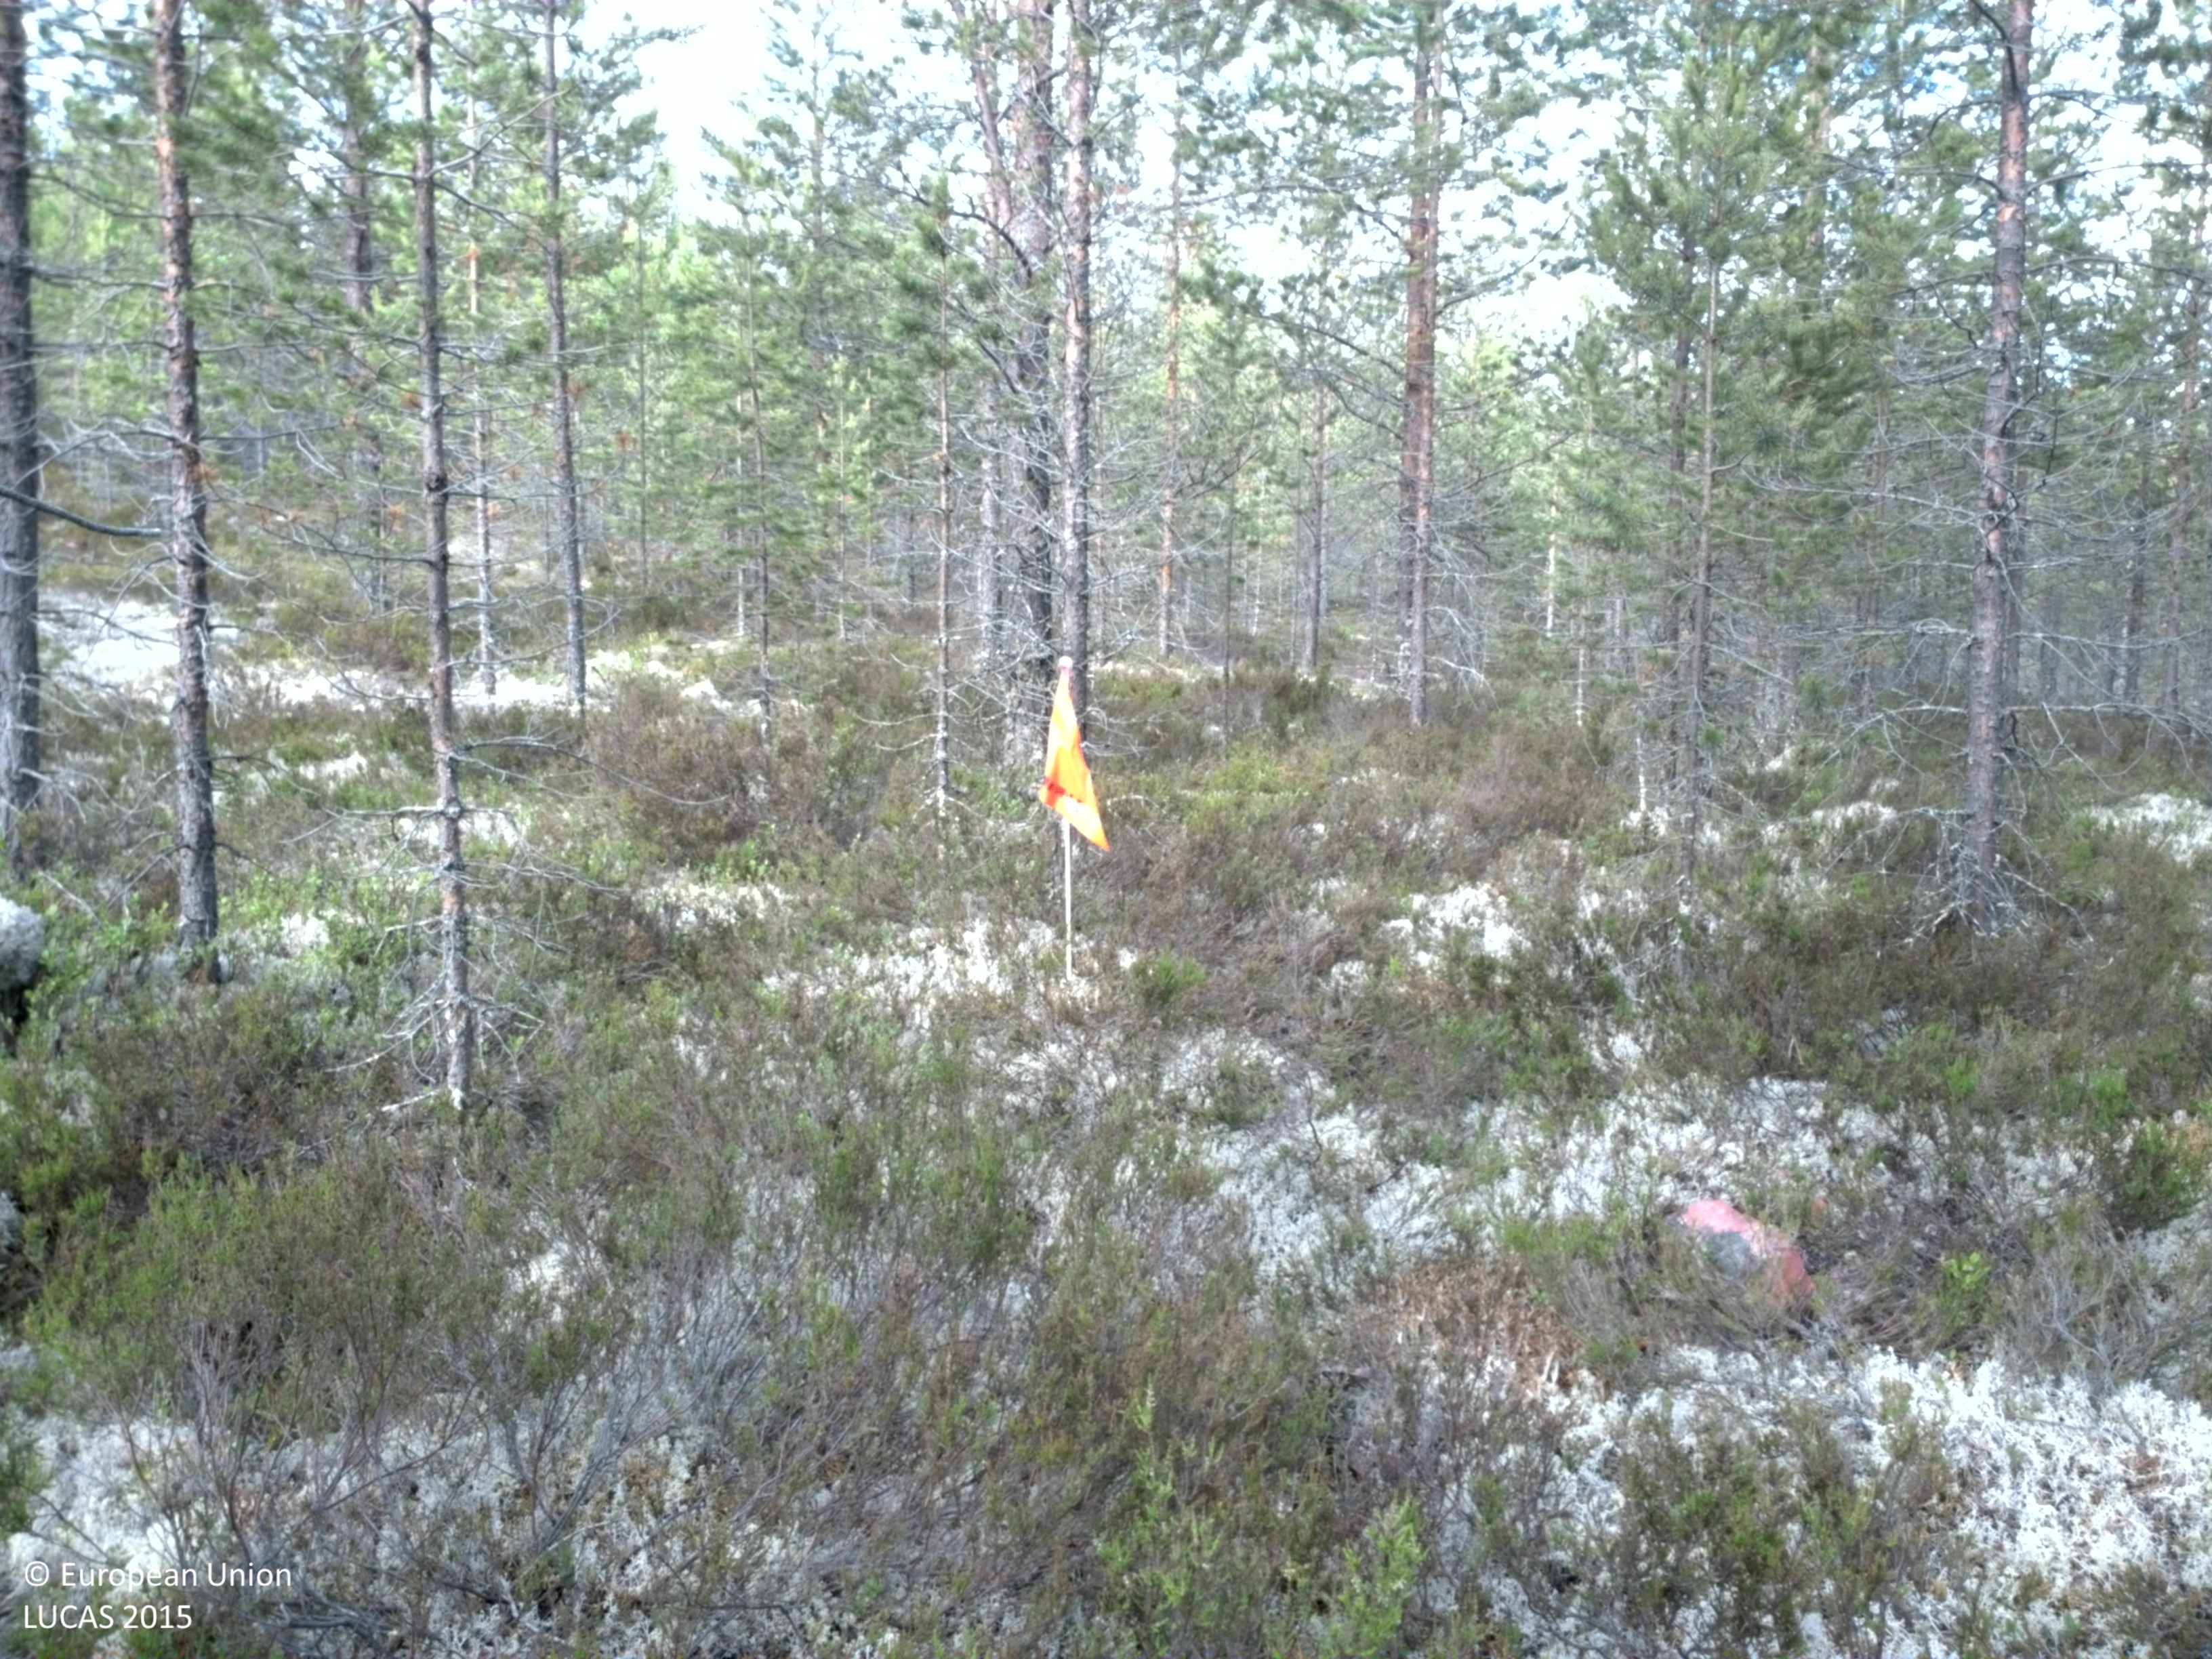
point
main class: Woodland
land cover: Pine dominated coniferous woodland
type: boreal forest
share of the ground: 50 - 75 %
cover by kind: coniferous forest trees 60 %, shrubs 20 %, lichens and mosses 20 %
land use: Forestry
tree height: < 5 m
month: July
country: SE
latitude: 61.5045
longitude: 13.6133
